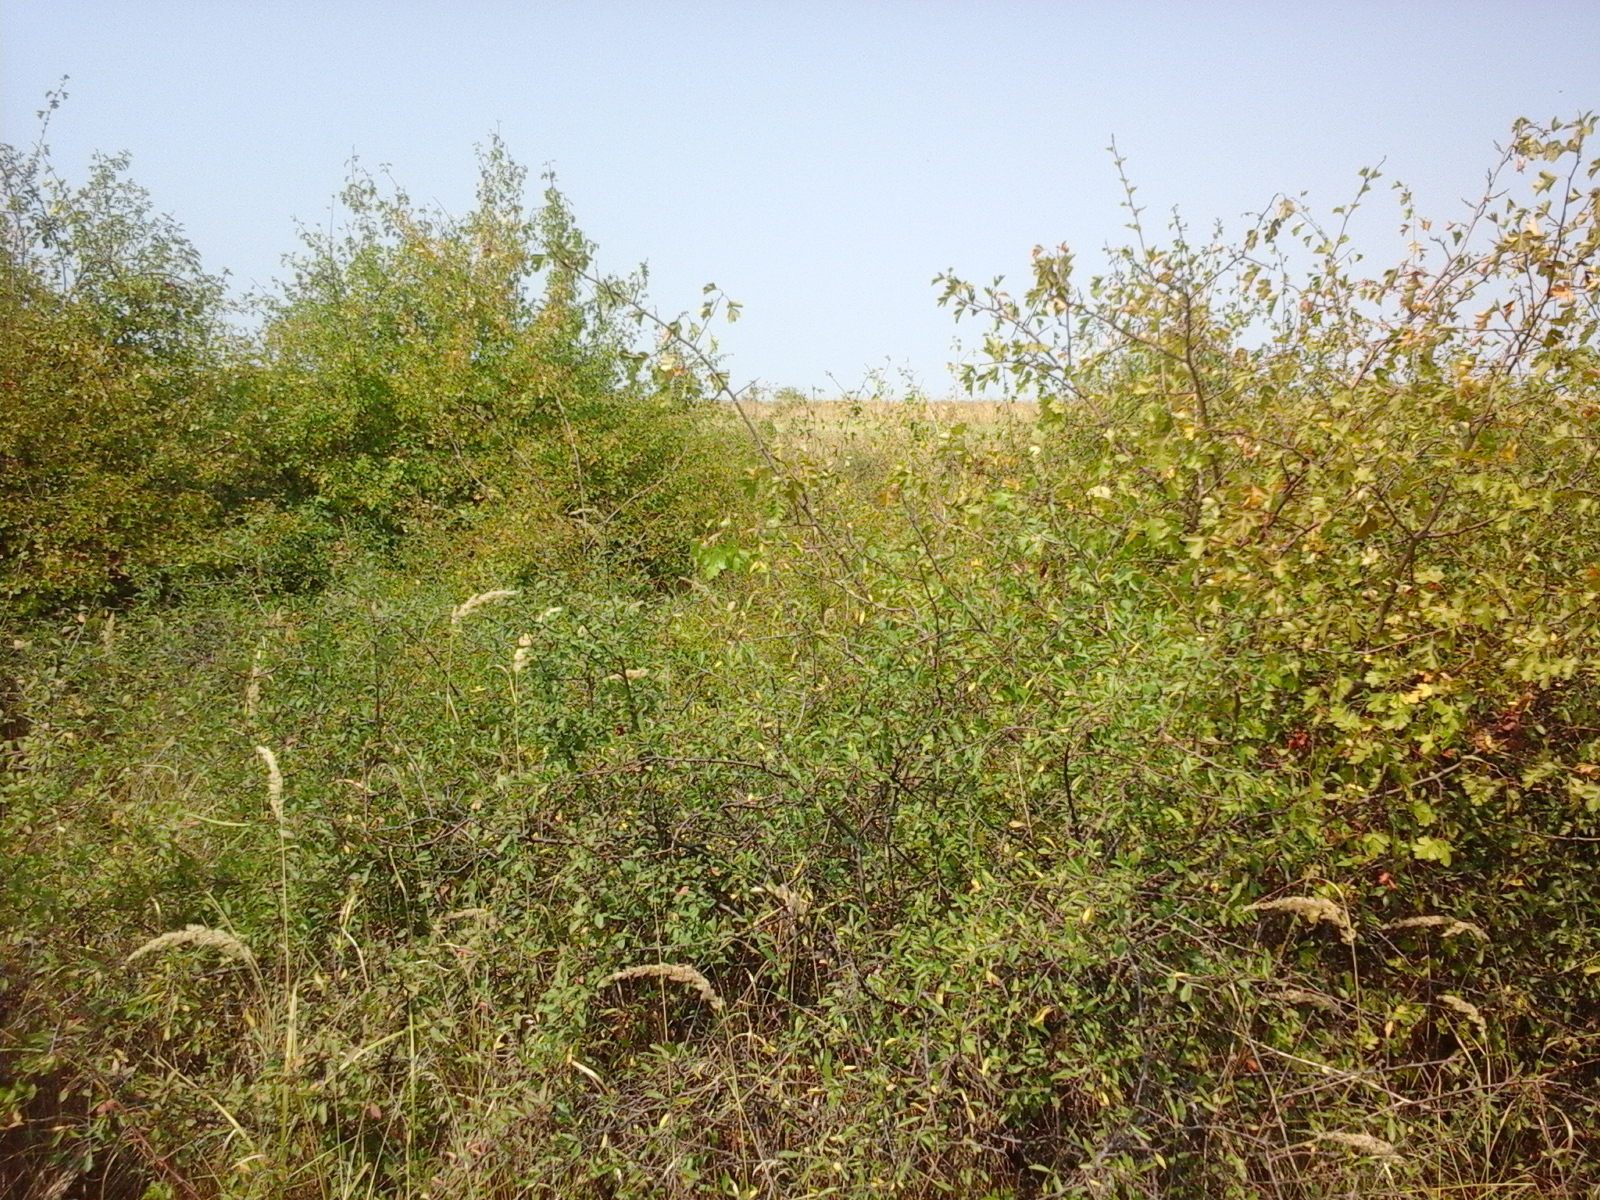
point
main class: Shrubland
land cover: Shrubland with sparse tree cover
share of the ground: > 75 %
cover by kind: shrubs 95 %, broadleaved forest trees 5 %
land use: Semi-natural and natural areas not in use
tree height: < 5 m
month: August
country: RO
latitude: 44.5042
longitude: 23.7805
